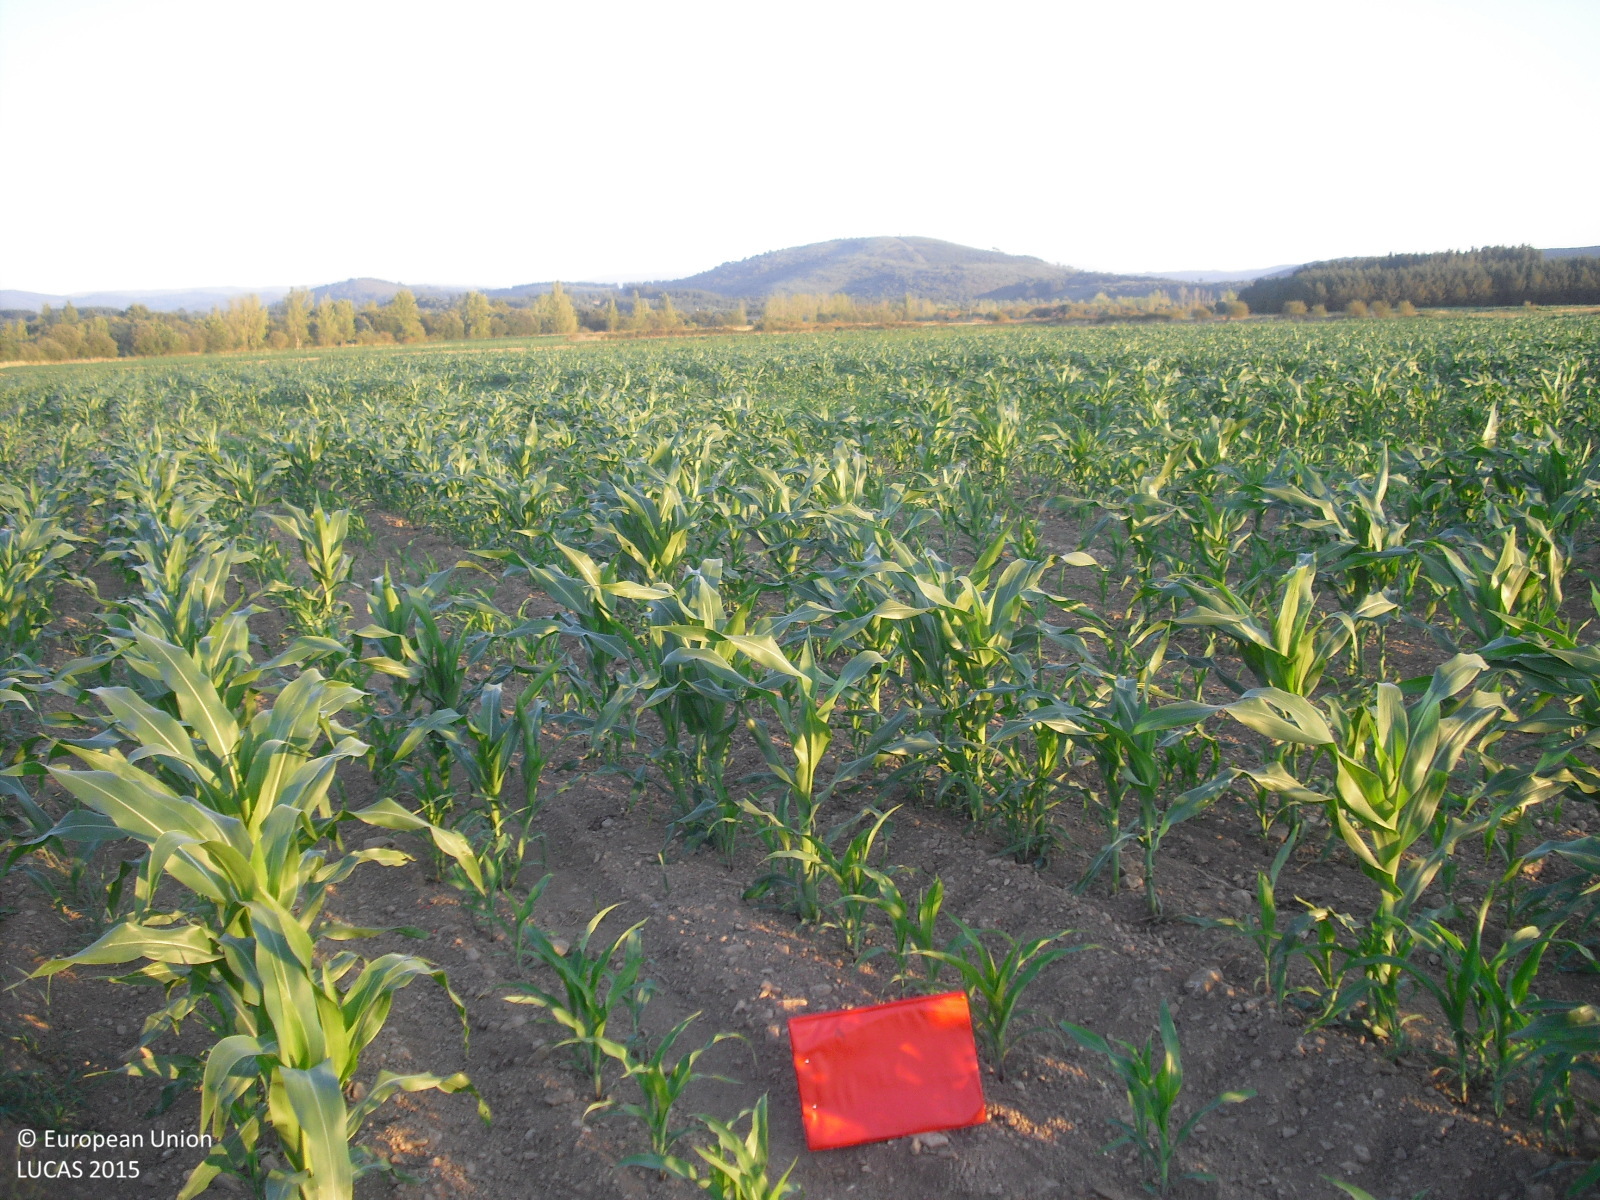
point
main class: Cropland
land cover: Maize
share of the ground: > 75 %
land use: Agriculture (excluding fallow land and kitchen gardens)
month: July
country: ES
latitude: 42.5980
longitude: -7.4610
